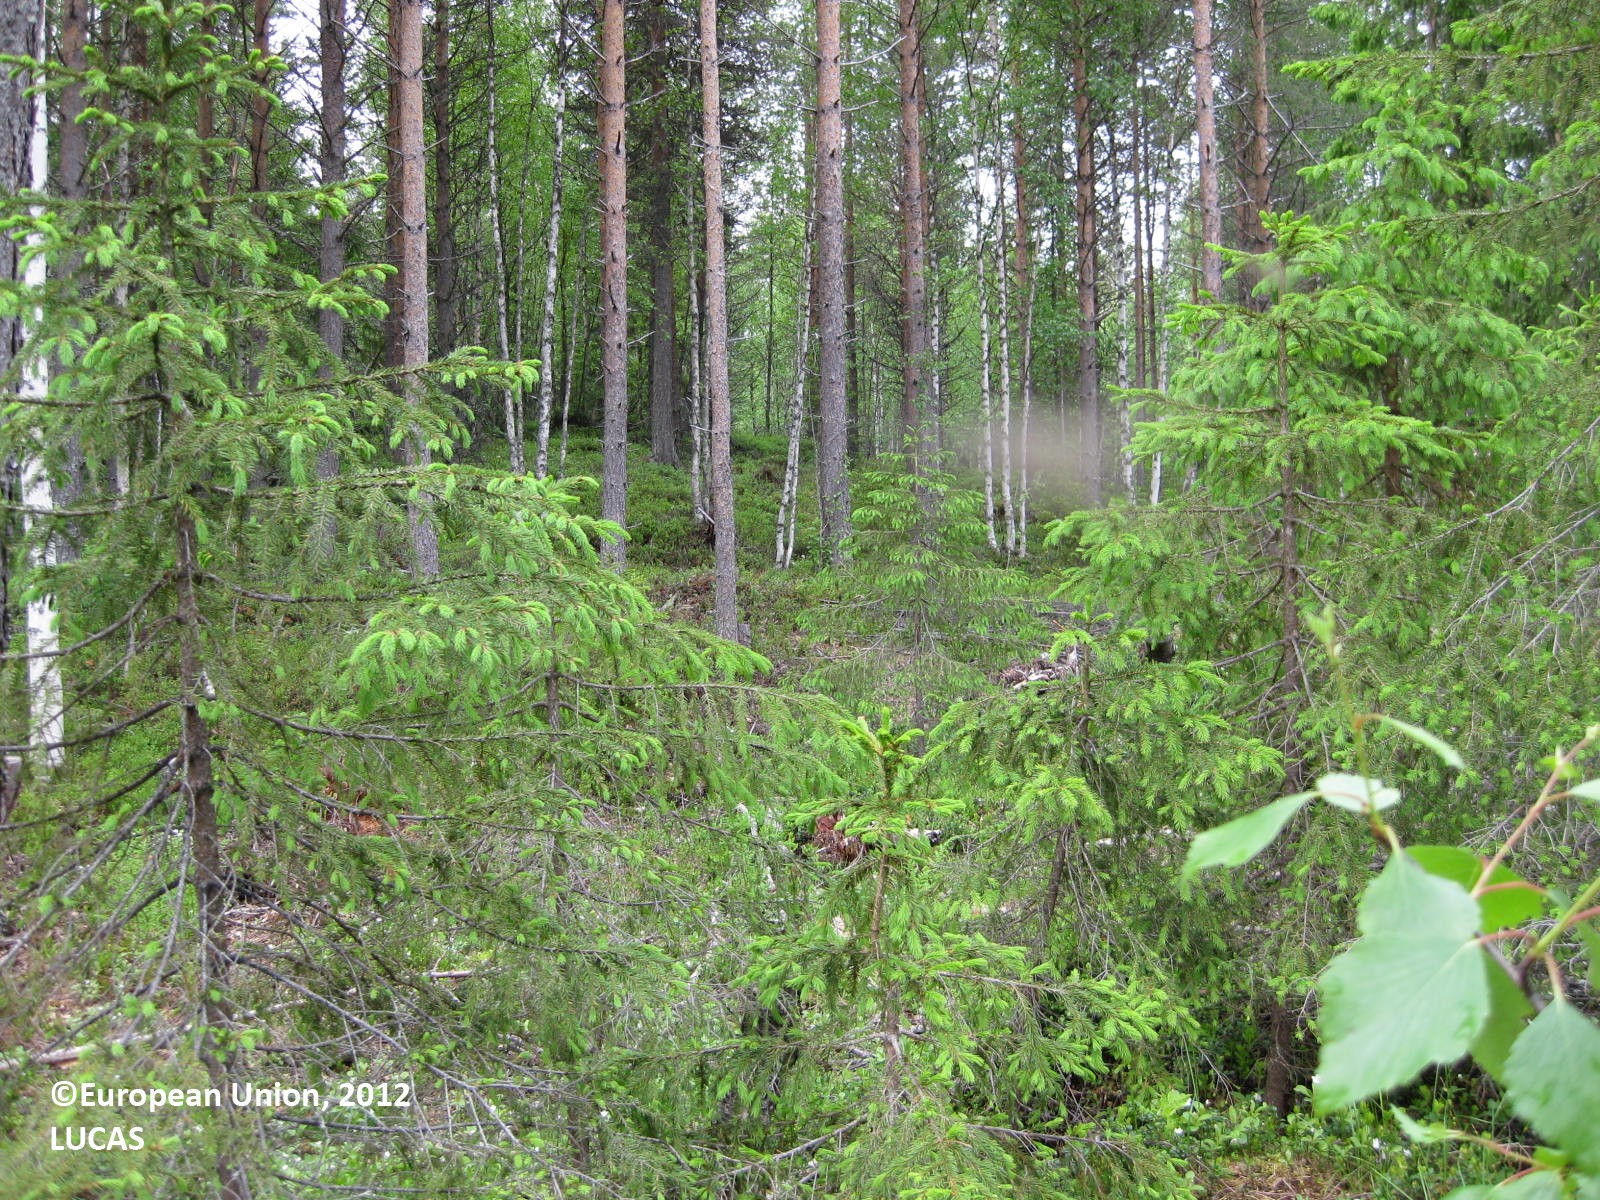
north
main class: Woodland
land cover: Spruce dominated mixed woodland
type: boreal forest
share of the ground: 50 - 75 %
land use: Forestry
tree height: > 5 m
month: June
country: FI
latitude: 65.2217
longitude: 29.4239
